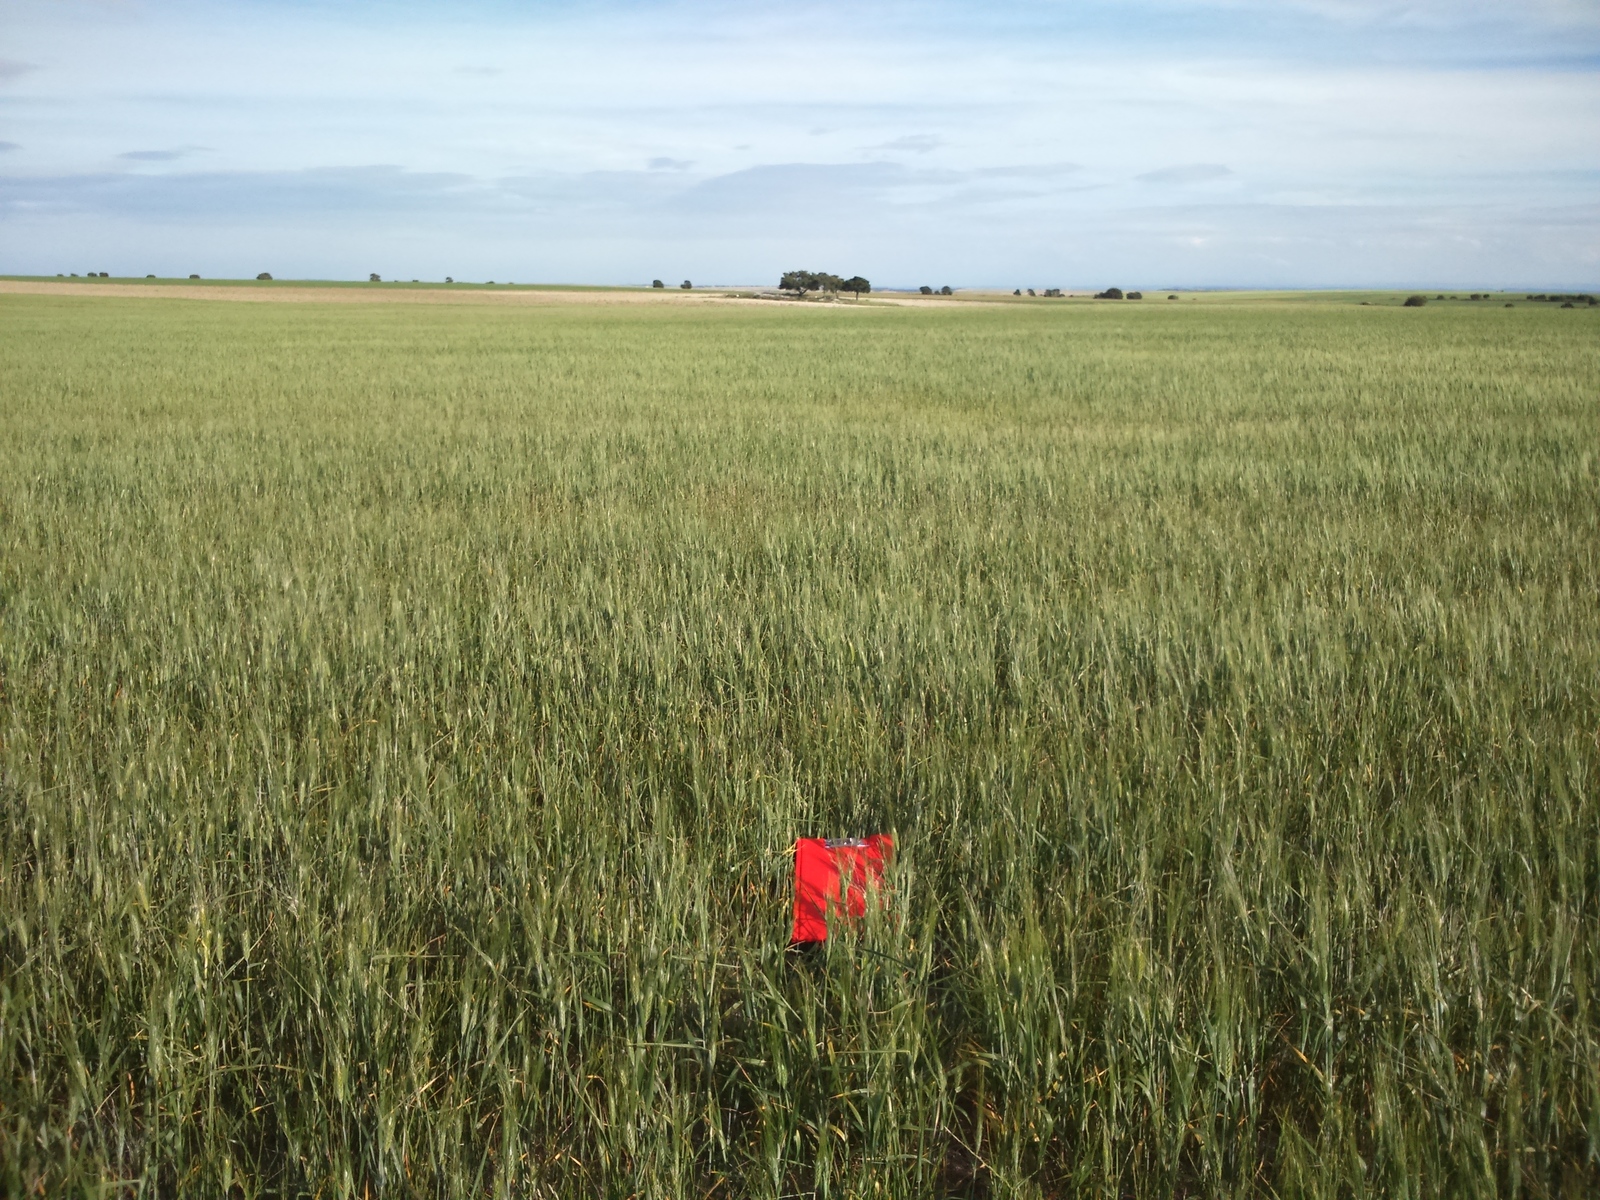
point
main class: Cropland
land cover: Durum wheat
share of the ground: > 75 %
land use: Agriculture (excluding fallow land and kitchen gardens)
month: April
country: ES
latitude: 41.4592
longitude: -0.2517
